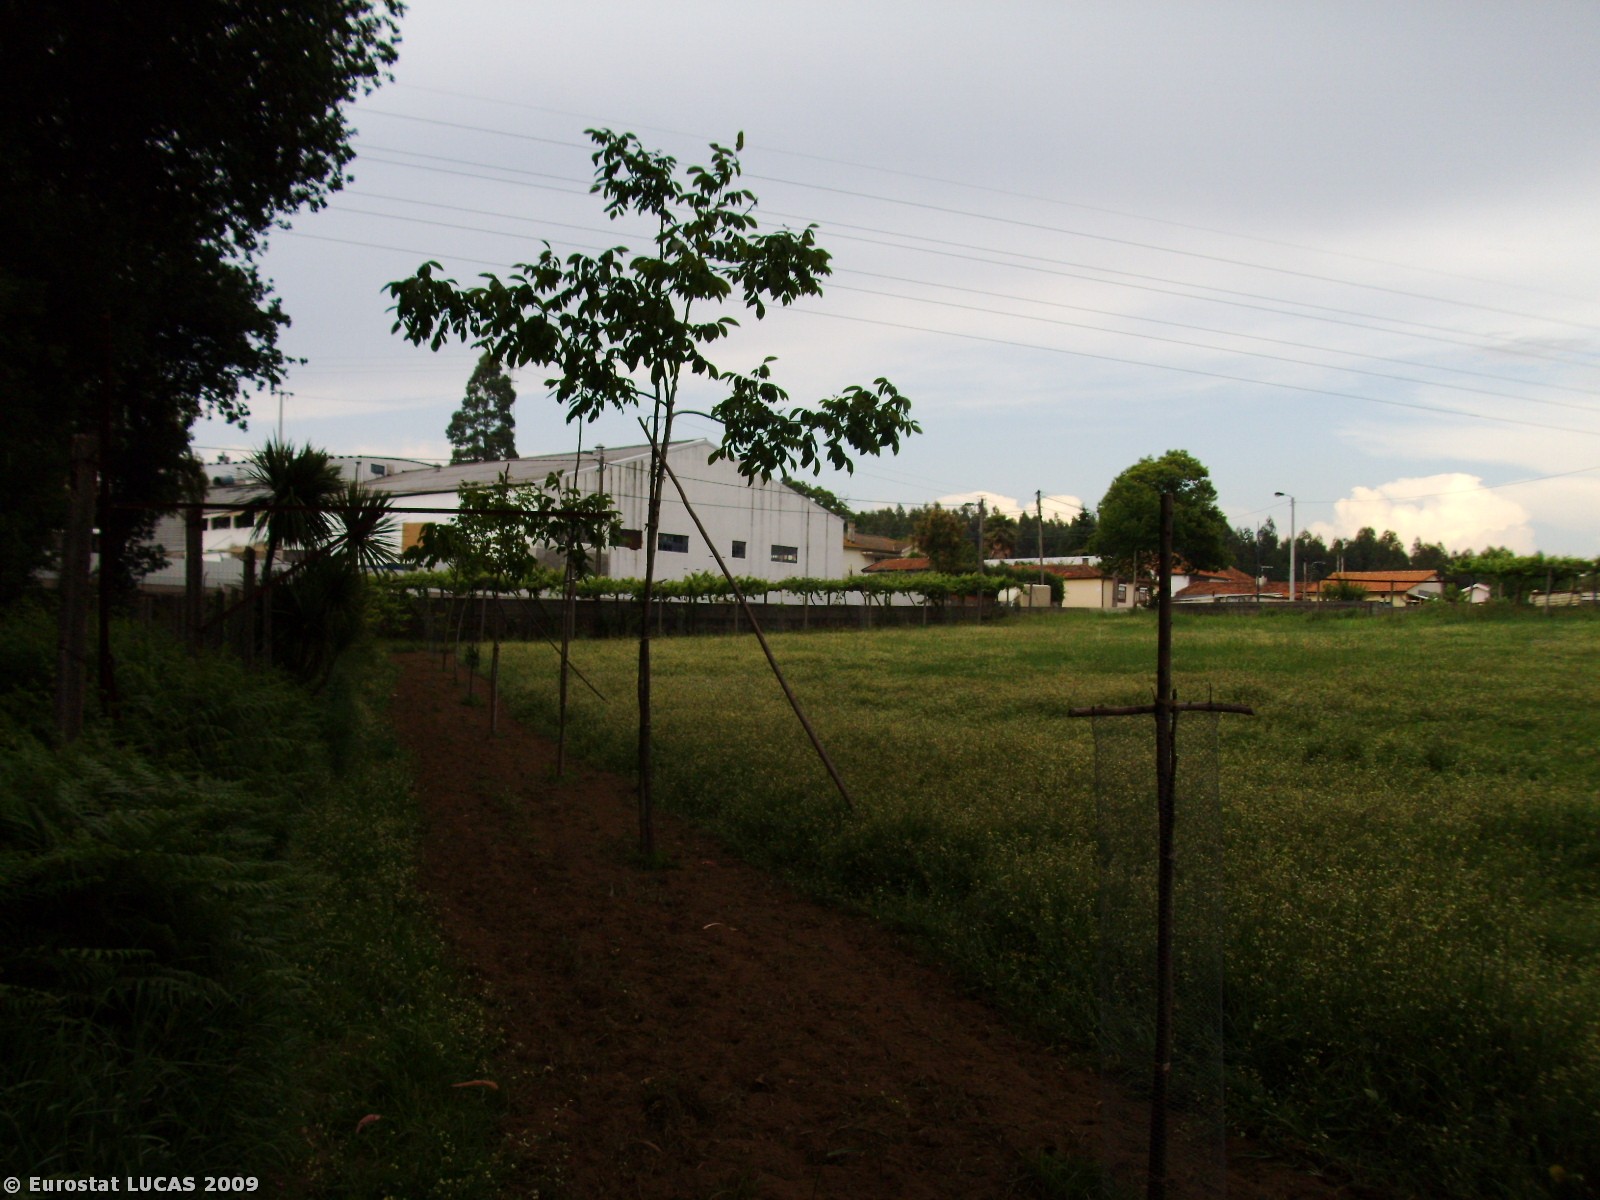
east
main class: Woodland
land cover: Broadleaved woodland
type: plantations and self-sown exotic forest
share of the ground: > 75 %
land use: Forestry
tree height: > 5 m
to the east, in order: Broadleaved woodland; Fences; Spontaneously vegetated surfaces; Electric lines; Spontaneously vegetated surfaces; Vineyards; Artificial constructions; Electric lines; Paved roads, cycling and walking lanes; Artificial constructions in urban areas; Fences; Spontaneously vegetated surfaces; Artificial constructions; Paved roads, cycling and walking lanes; Artificial constructions in urban areas; Groves; Spontaneously vegetated surfaces; Other fruit trees and berries; Shrubland without tree cover
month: May
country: PT
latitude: 41.0904
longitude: -8.5424
